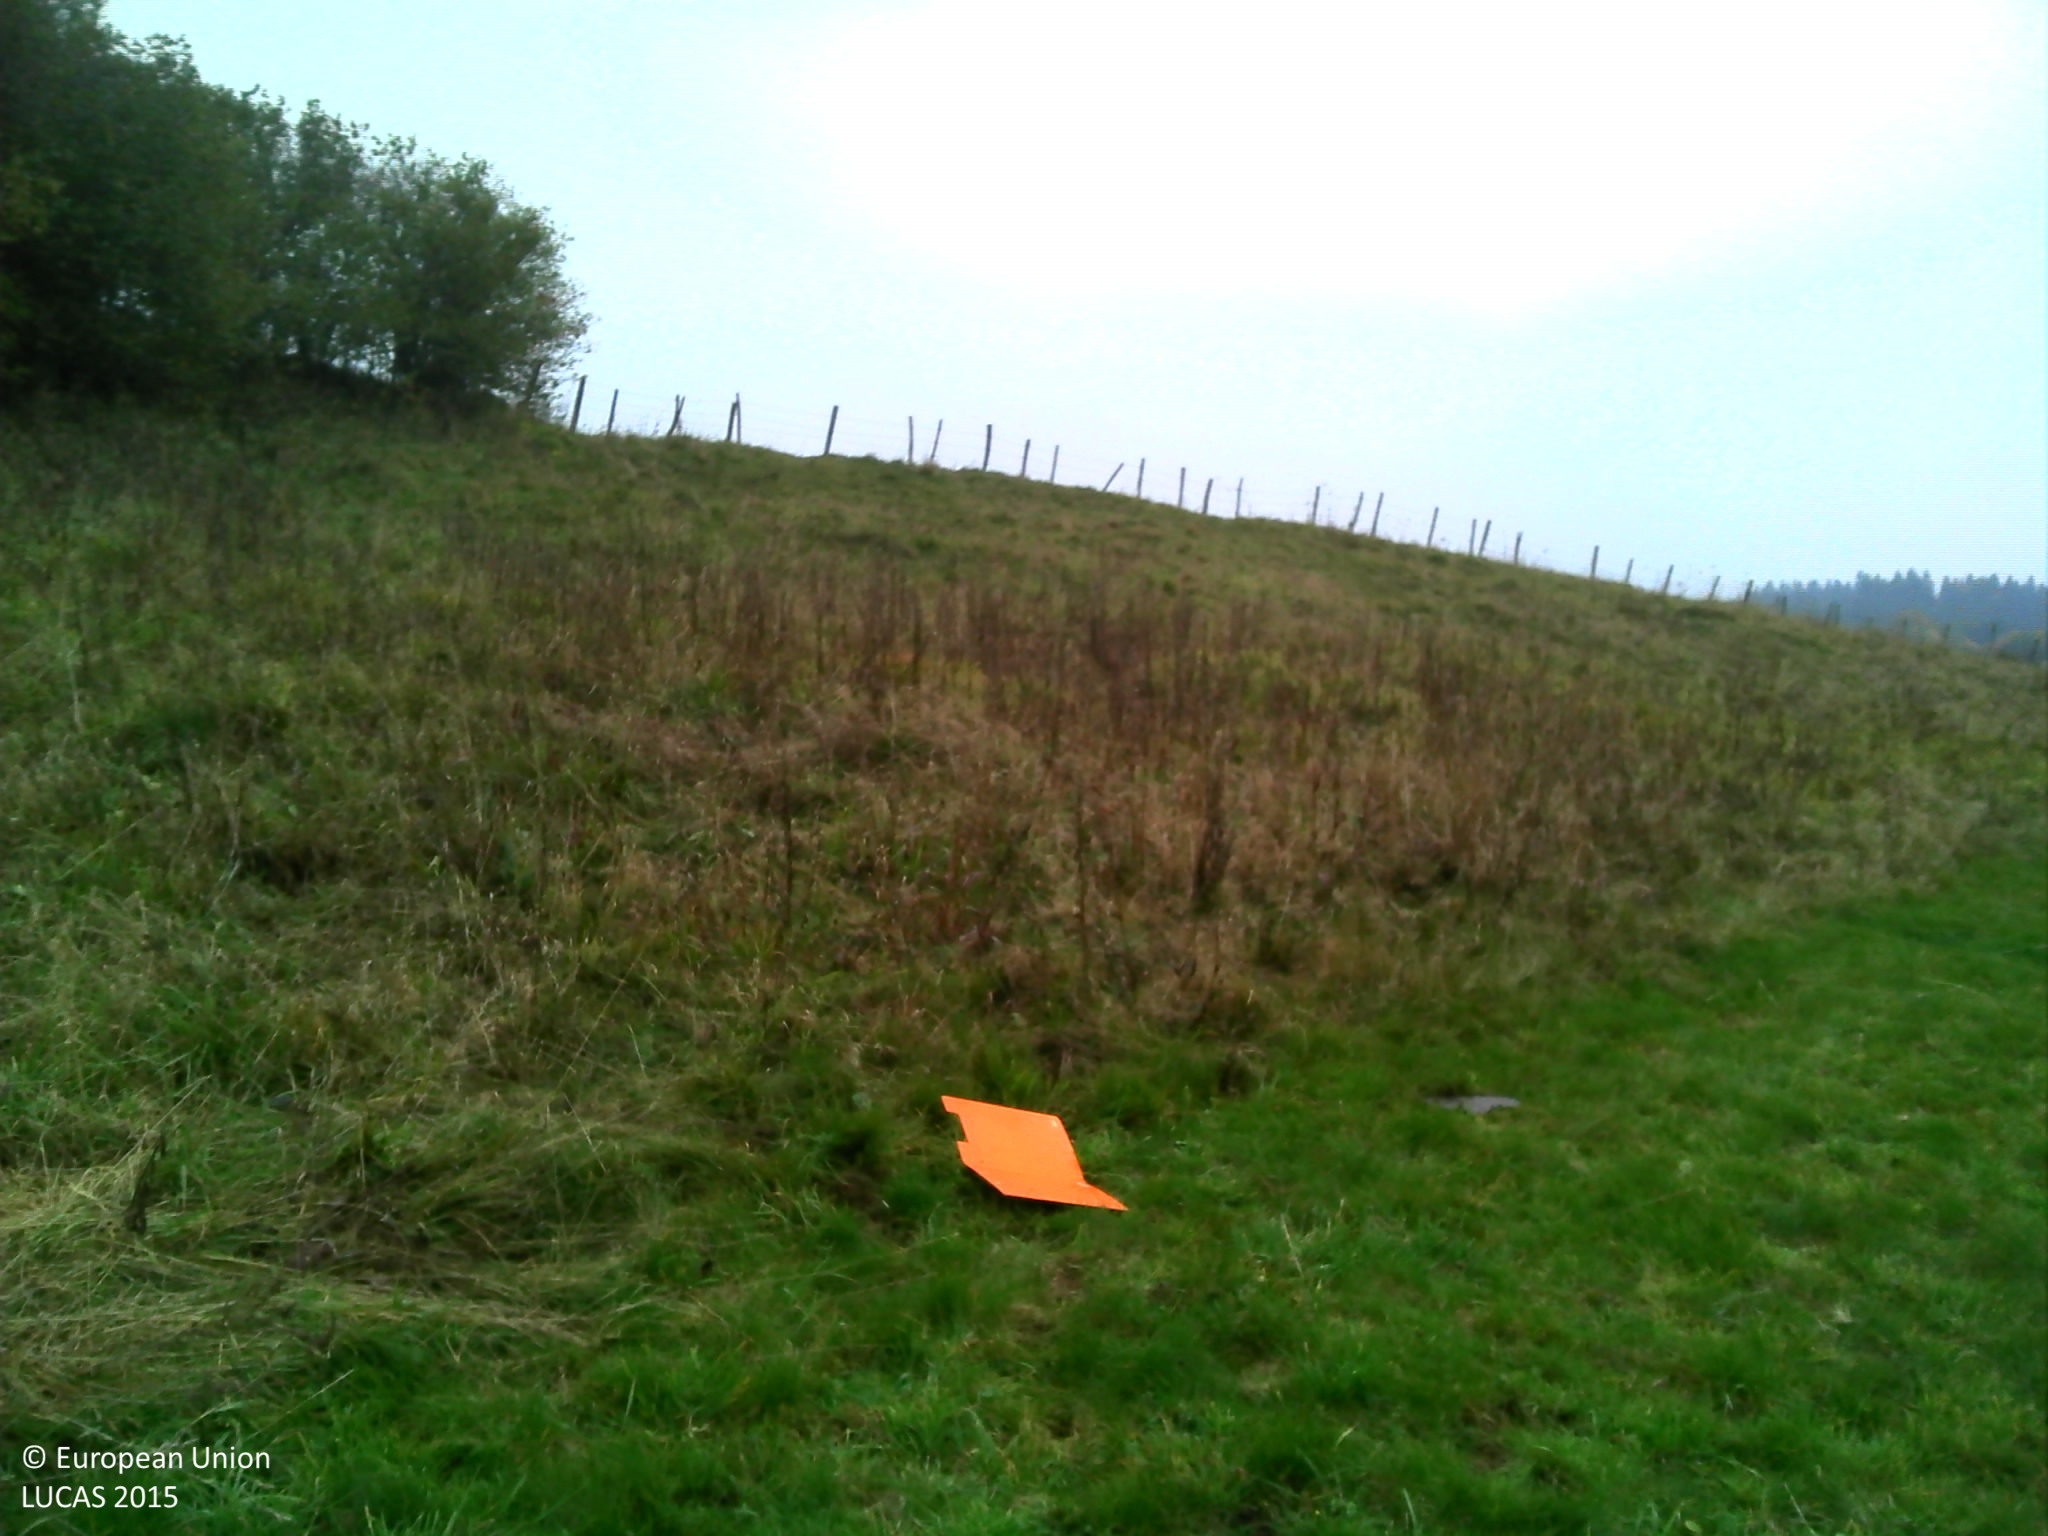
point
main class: Grassland
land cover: Grassland without tree/shrub cover
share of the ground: > 75 %
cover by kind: herbaceous plants 100 %
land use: Agriculture (excluding fallow land and kitchen gardens)
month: October
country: FR
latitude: 46.9131
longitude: 6.1553
